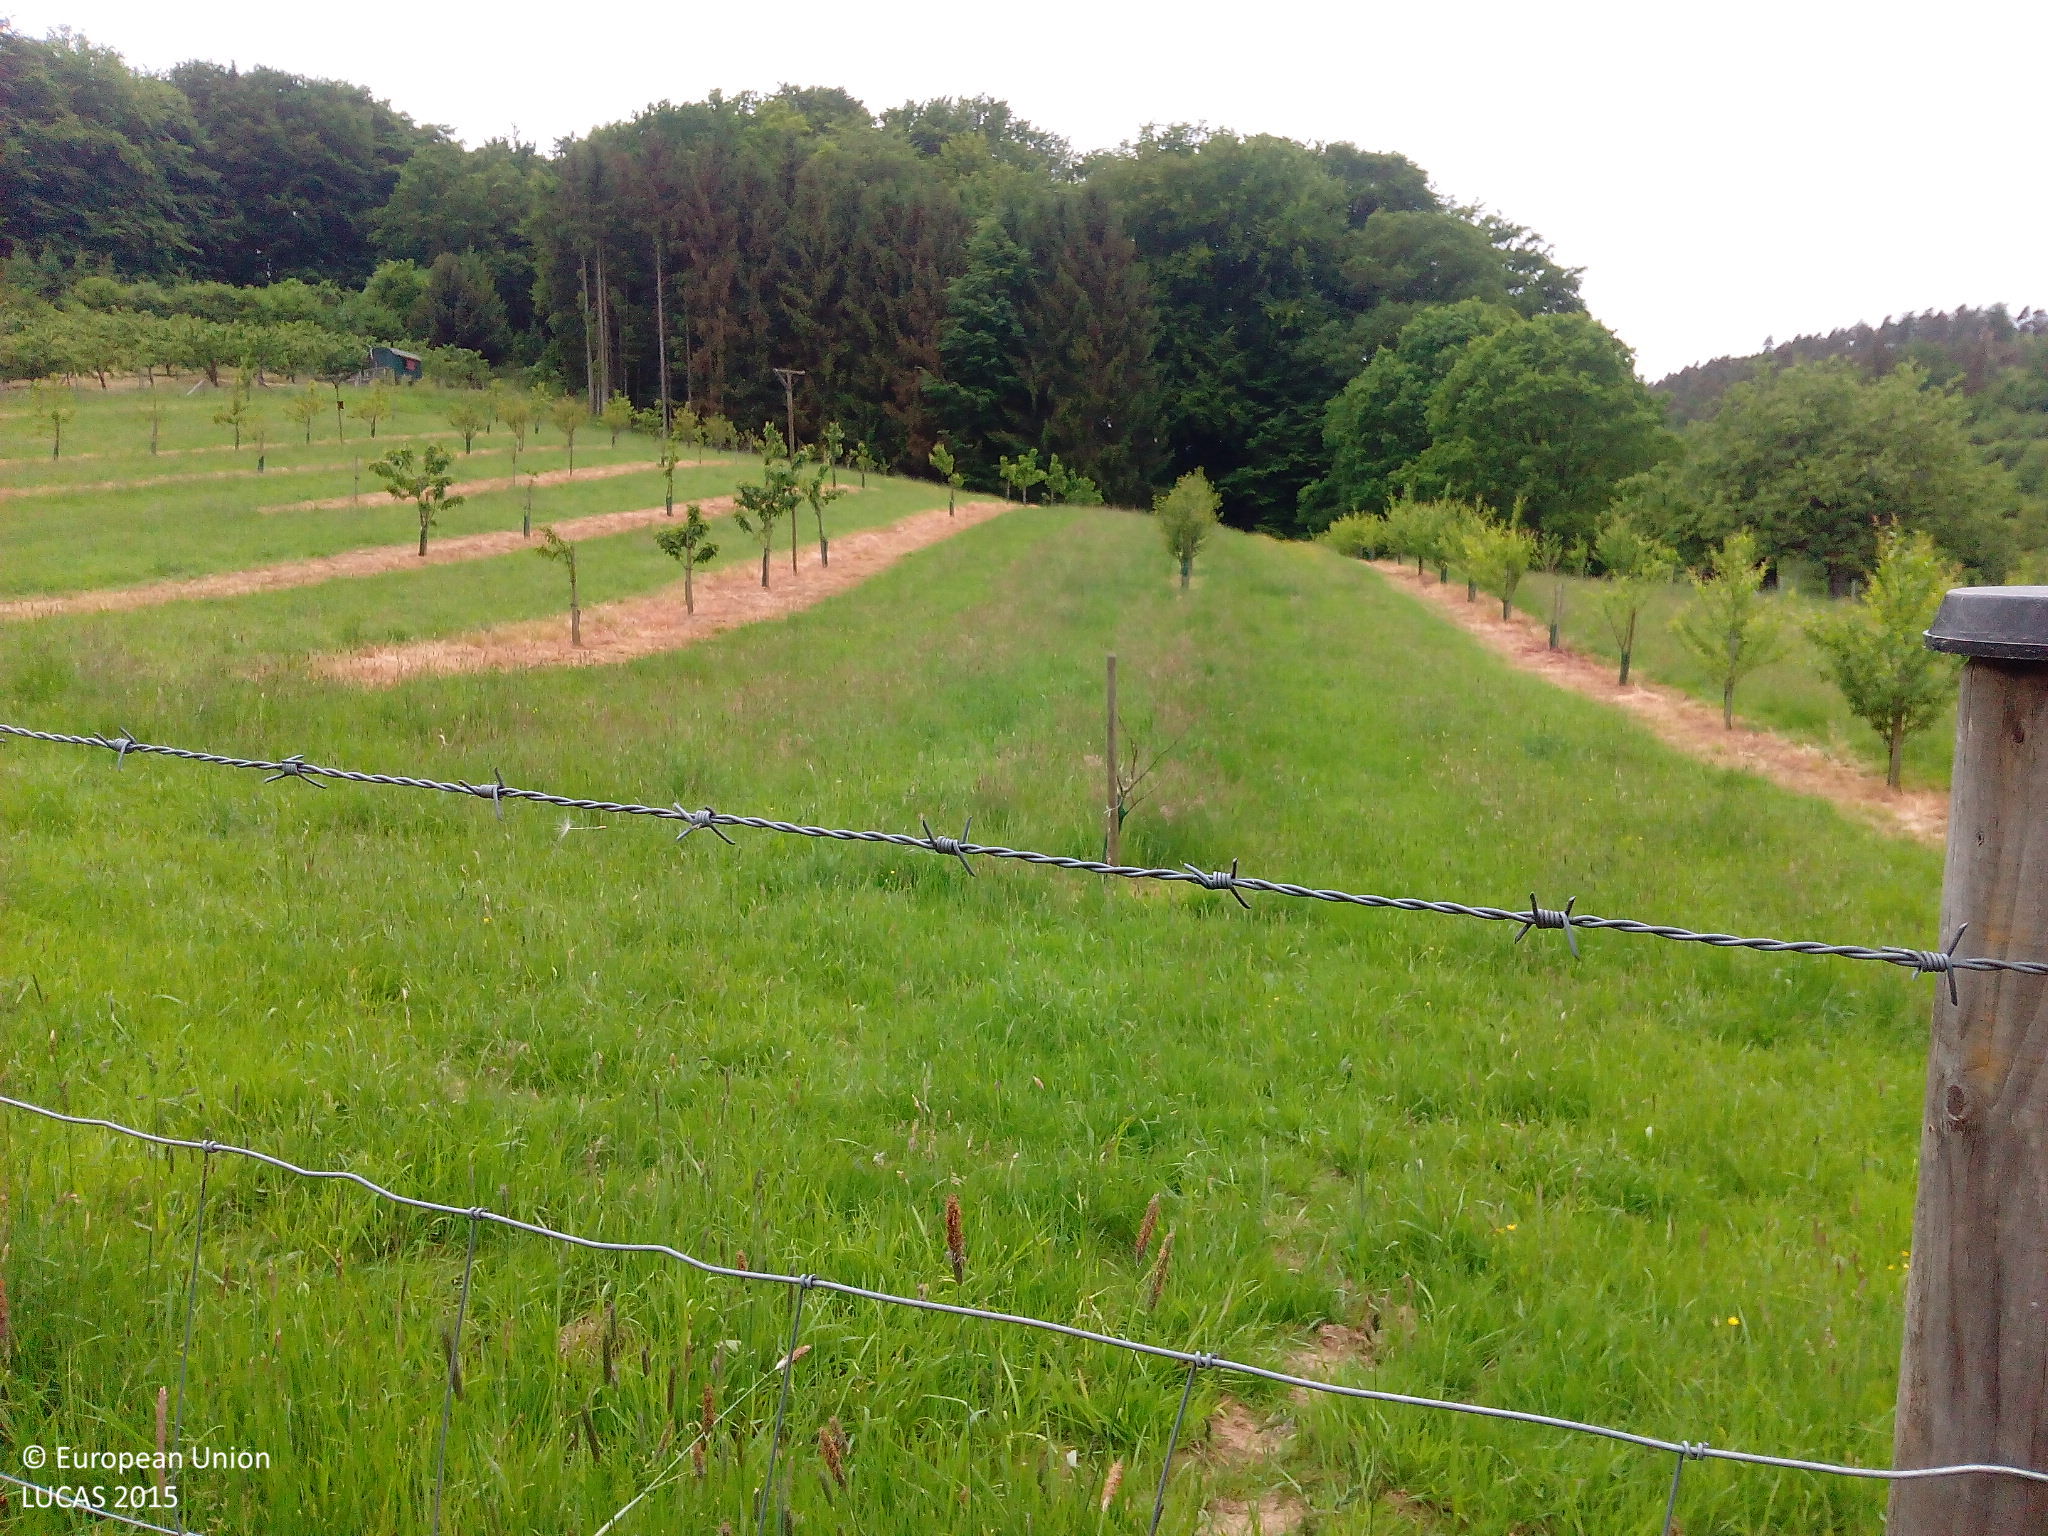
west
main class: Cropland
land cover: Cherry fruit
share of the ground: < 10 %
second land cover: Grassland without tree/shrub cover
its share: > 75 %
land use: Agriculture (excluding fallow land and kitchen gardens)
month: May
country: DE
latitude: 51.3169
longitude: 9.8709
